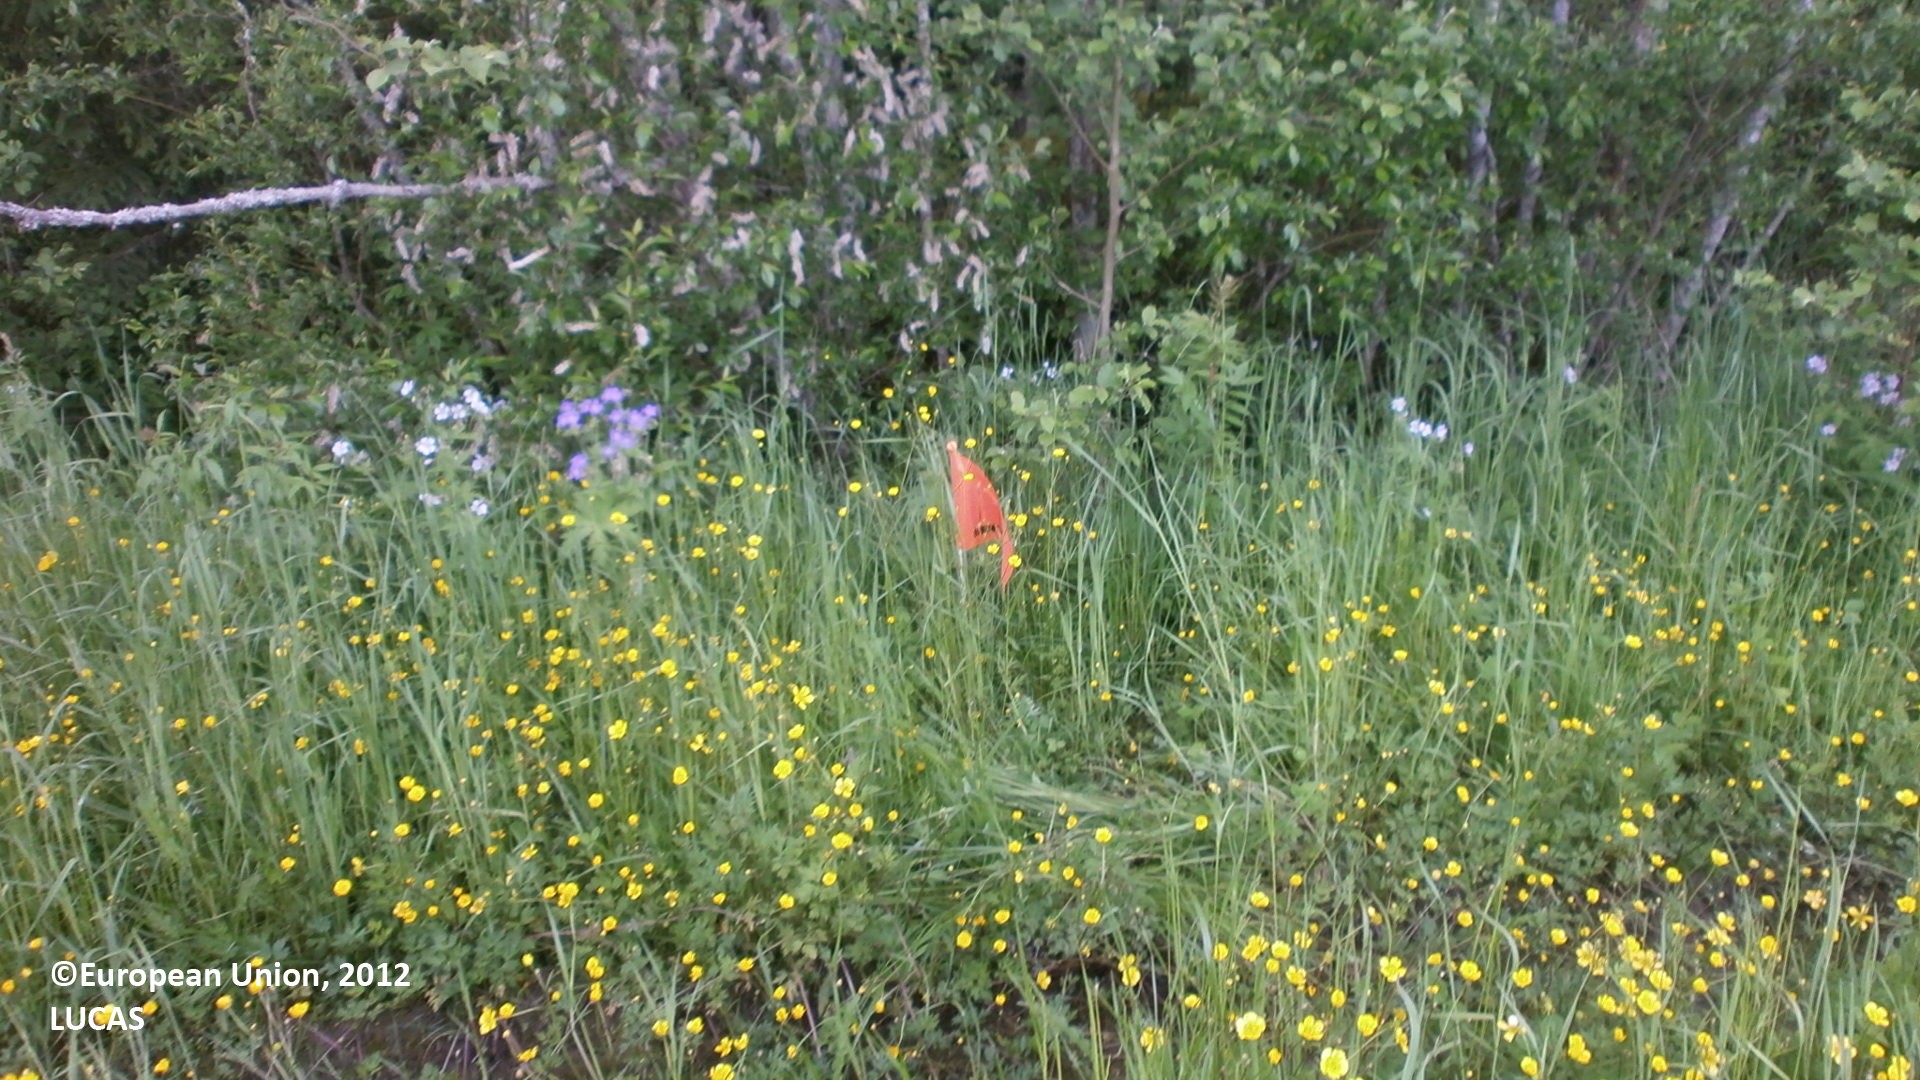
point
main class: Grassland
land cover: Grassland without tree/shrub cover
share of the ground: > 75 %
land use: Agriculture (excluding fallow land and kitchen gardens)
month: June
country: FI
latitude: 64.2303
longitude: 25.0291
